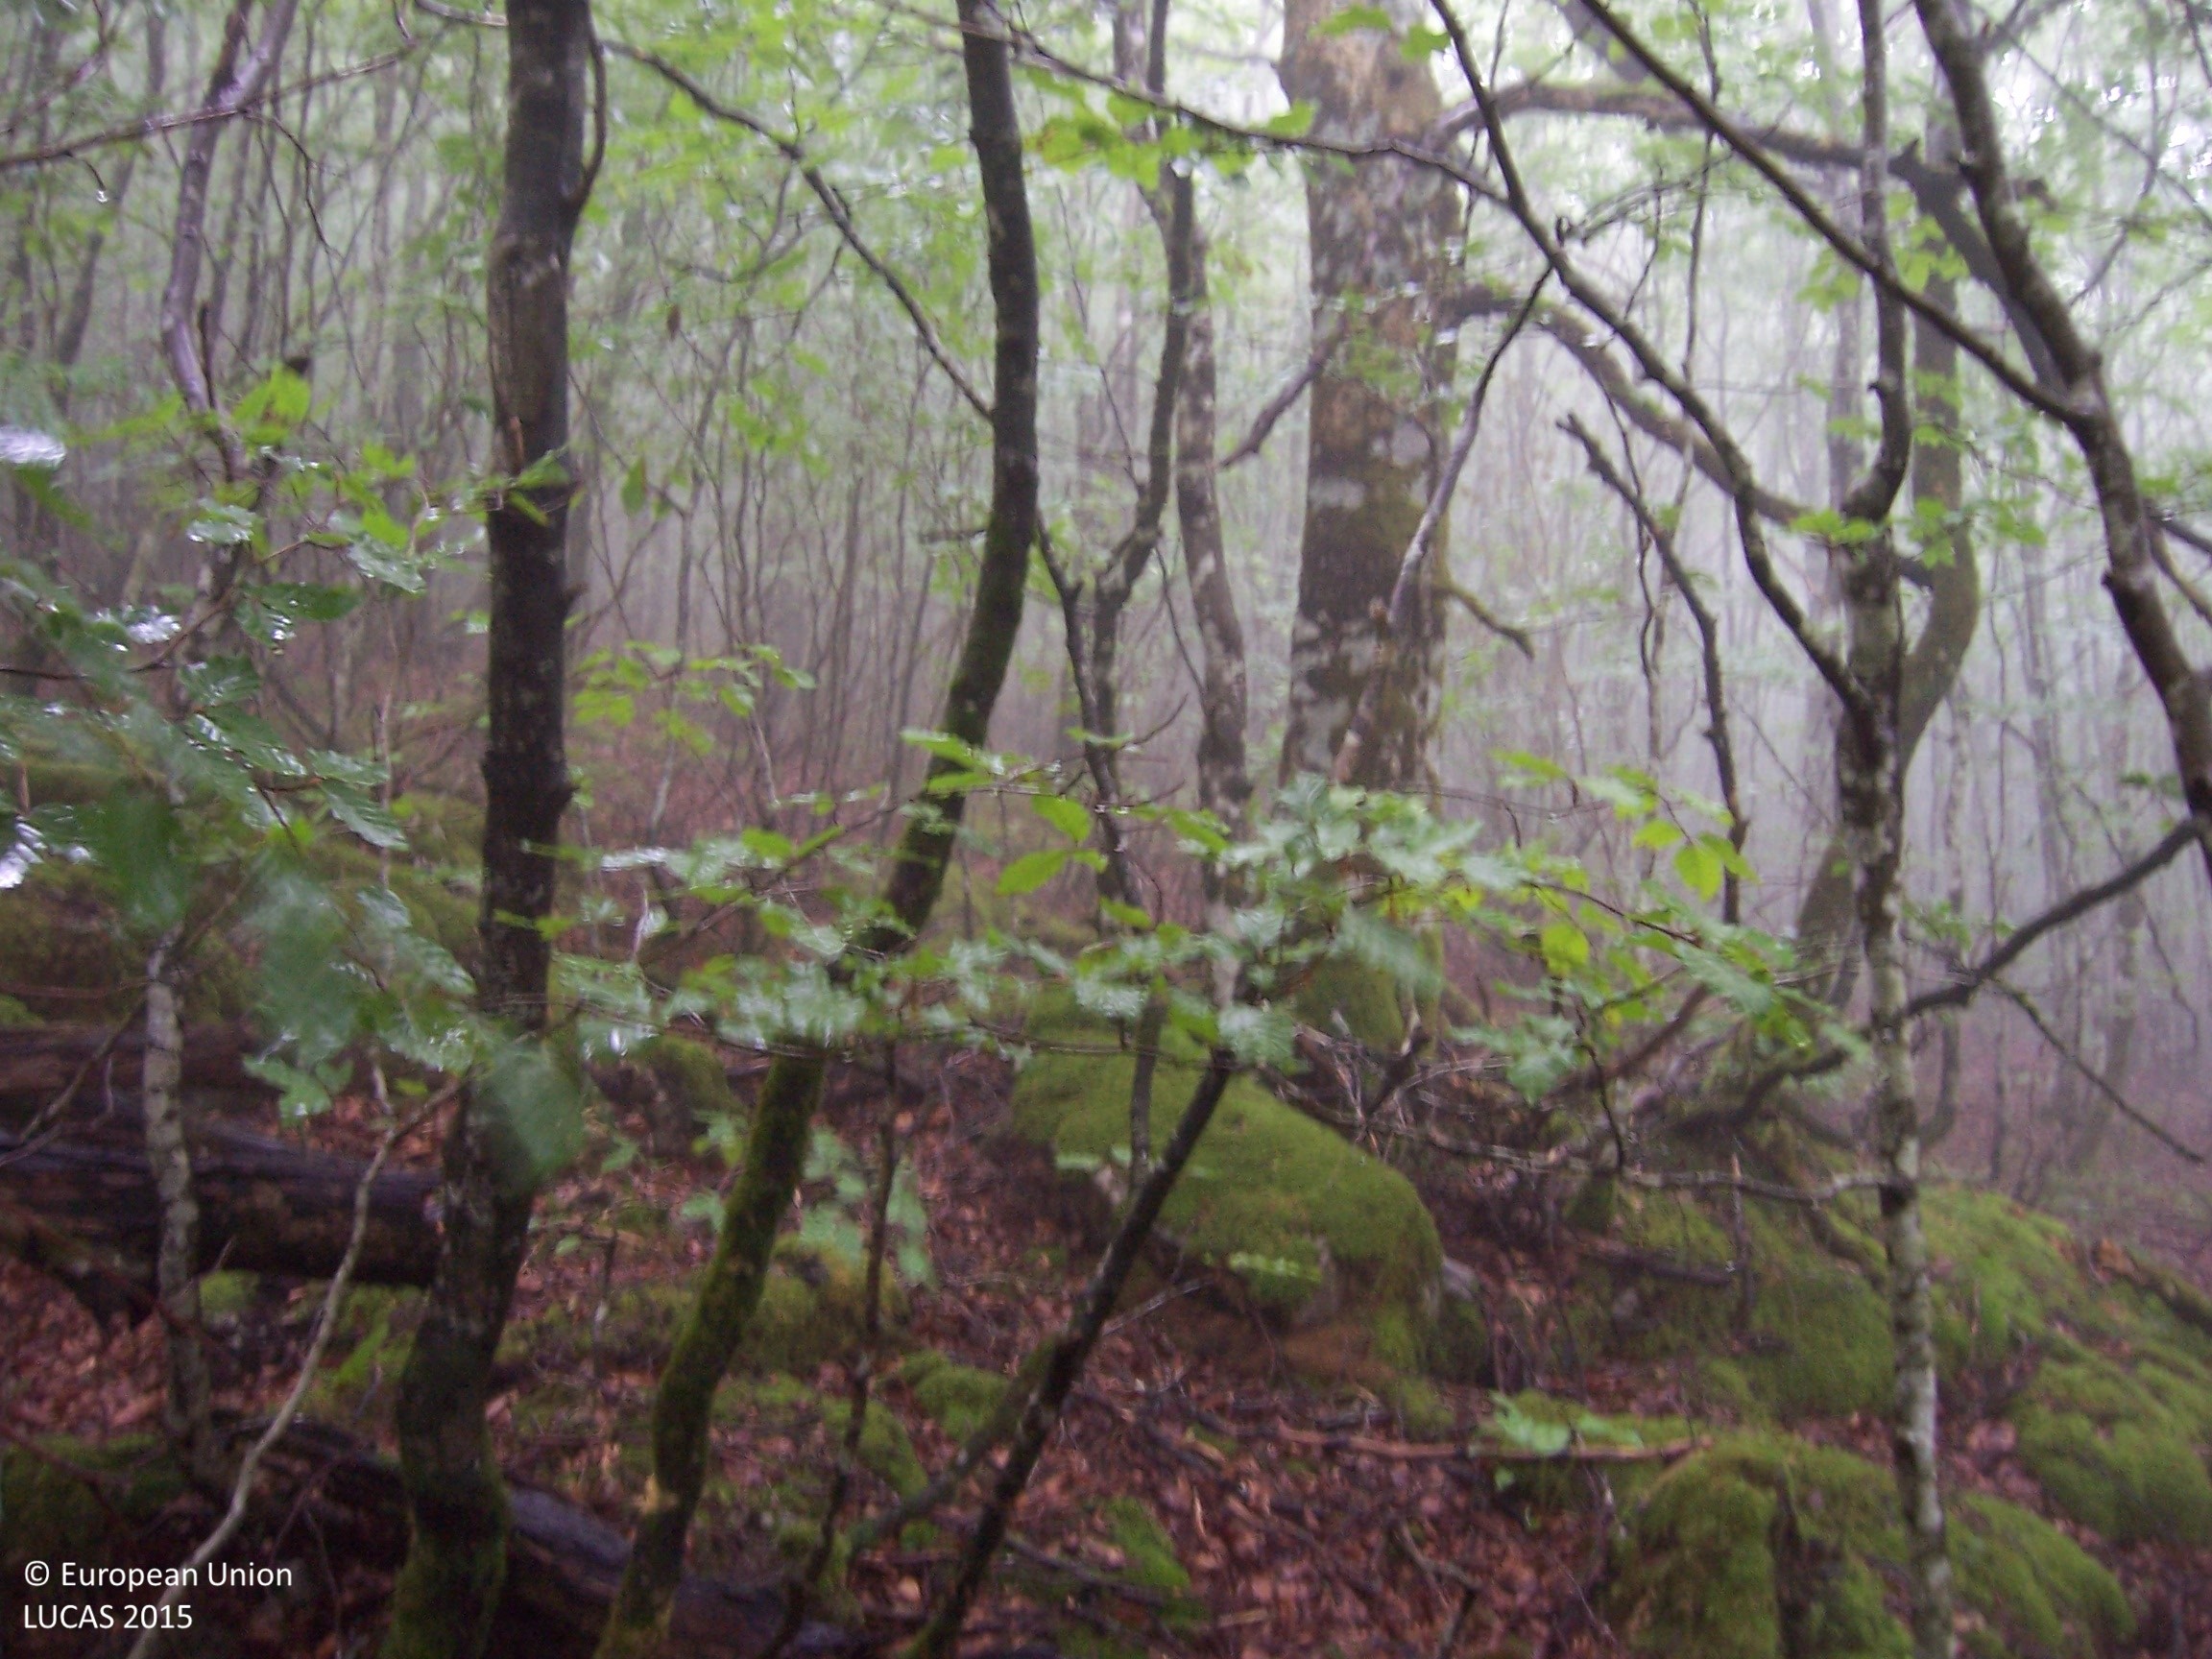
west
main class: Woodland
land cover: Broadleaved woodland
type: mountainous beech forest
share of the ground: > 75 %
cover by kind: broadleaved forest trees 100 %
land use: Forestry
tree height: > 5 m
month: July
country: ES
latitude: 43.0483
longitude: -1.2206
